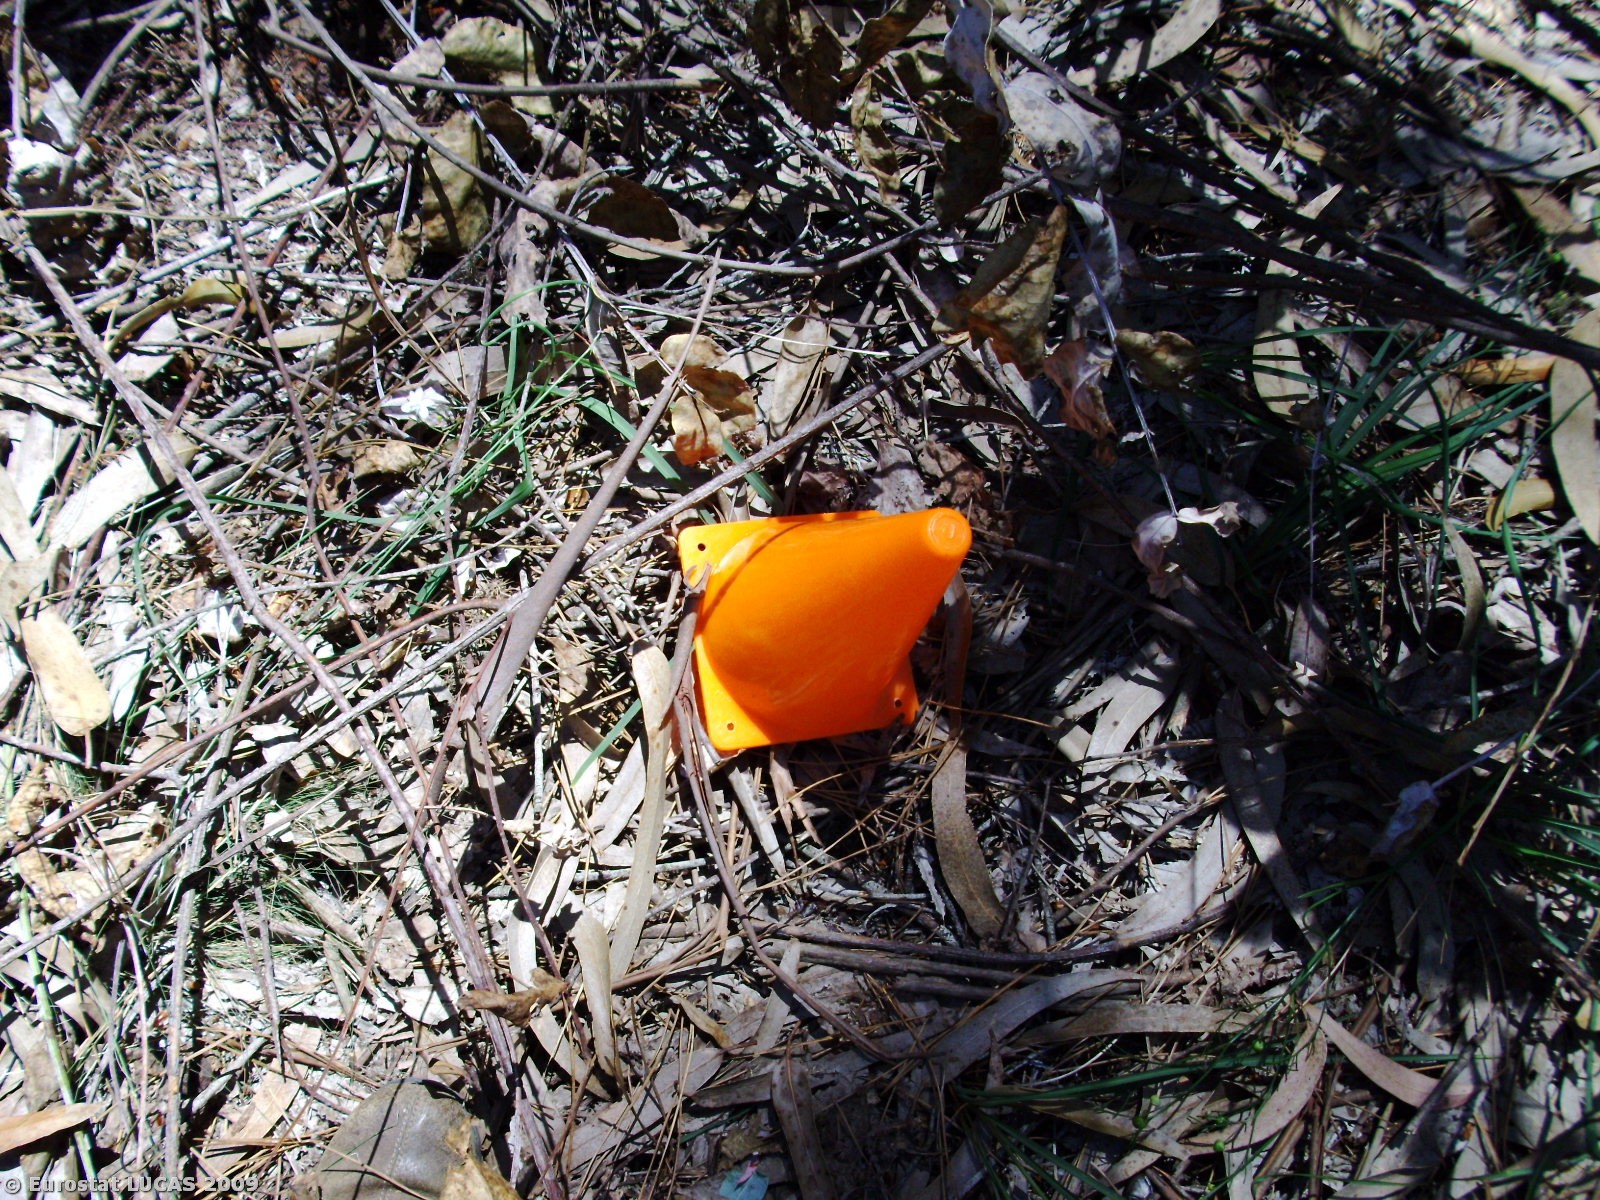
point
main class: Woodland
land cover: Mixed woodland
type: coniferous forest of the mediterranean region
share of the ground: > 75 %
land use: Forestry
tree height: > 5 m
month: May
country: PT
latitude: 40.7670
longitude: -8.4933
